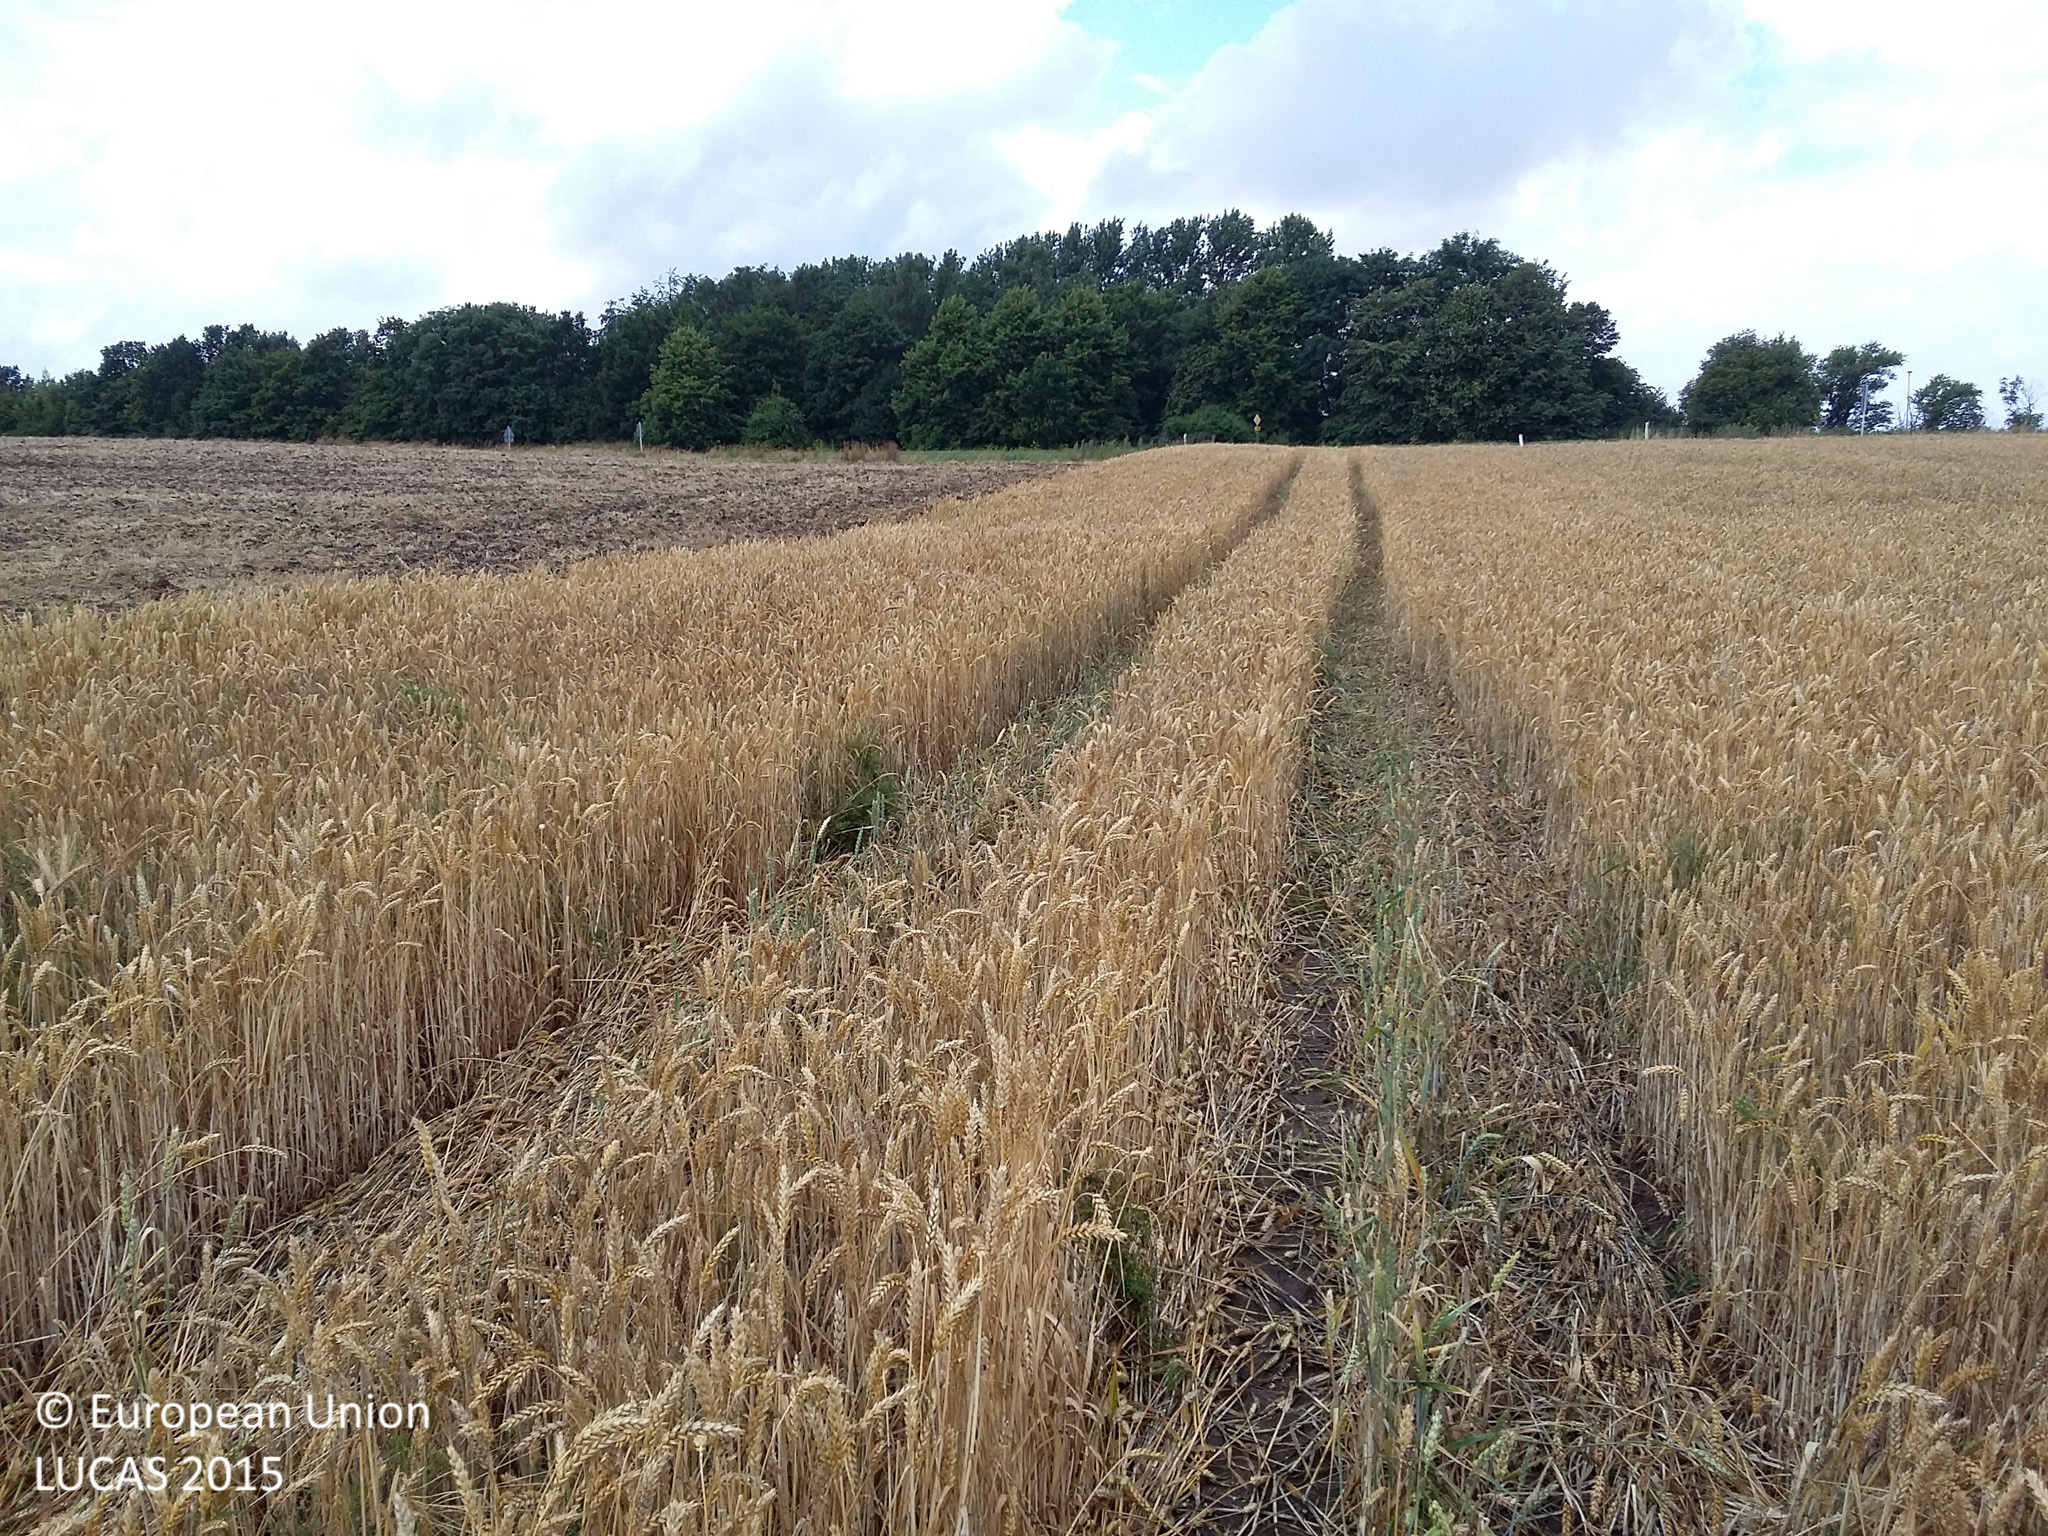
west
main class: Cropland
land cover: Common wheat
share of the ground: > 75 %
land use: Agriculture (excluding fallow land and kitchen gardens)
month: July
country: DK
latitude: 55.7741
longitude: 12.1502
